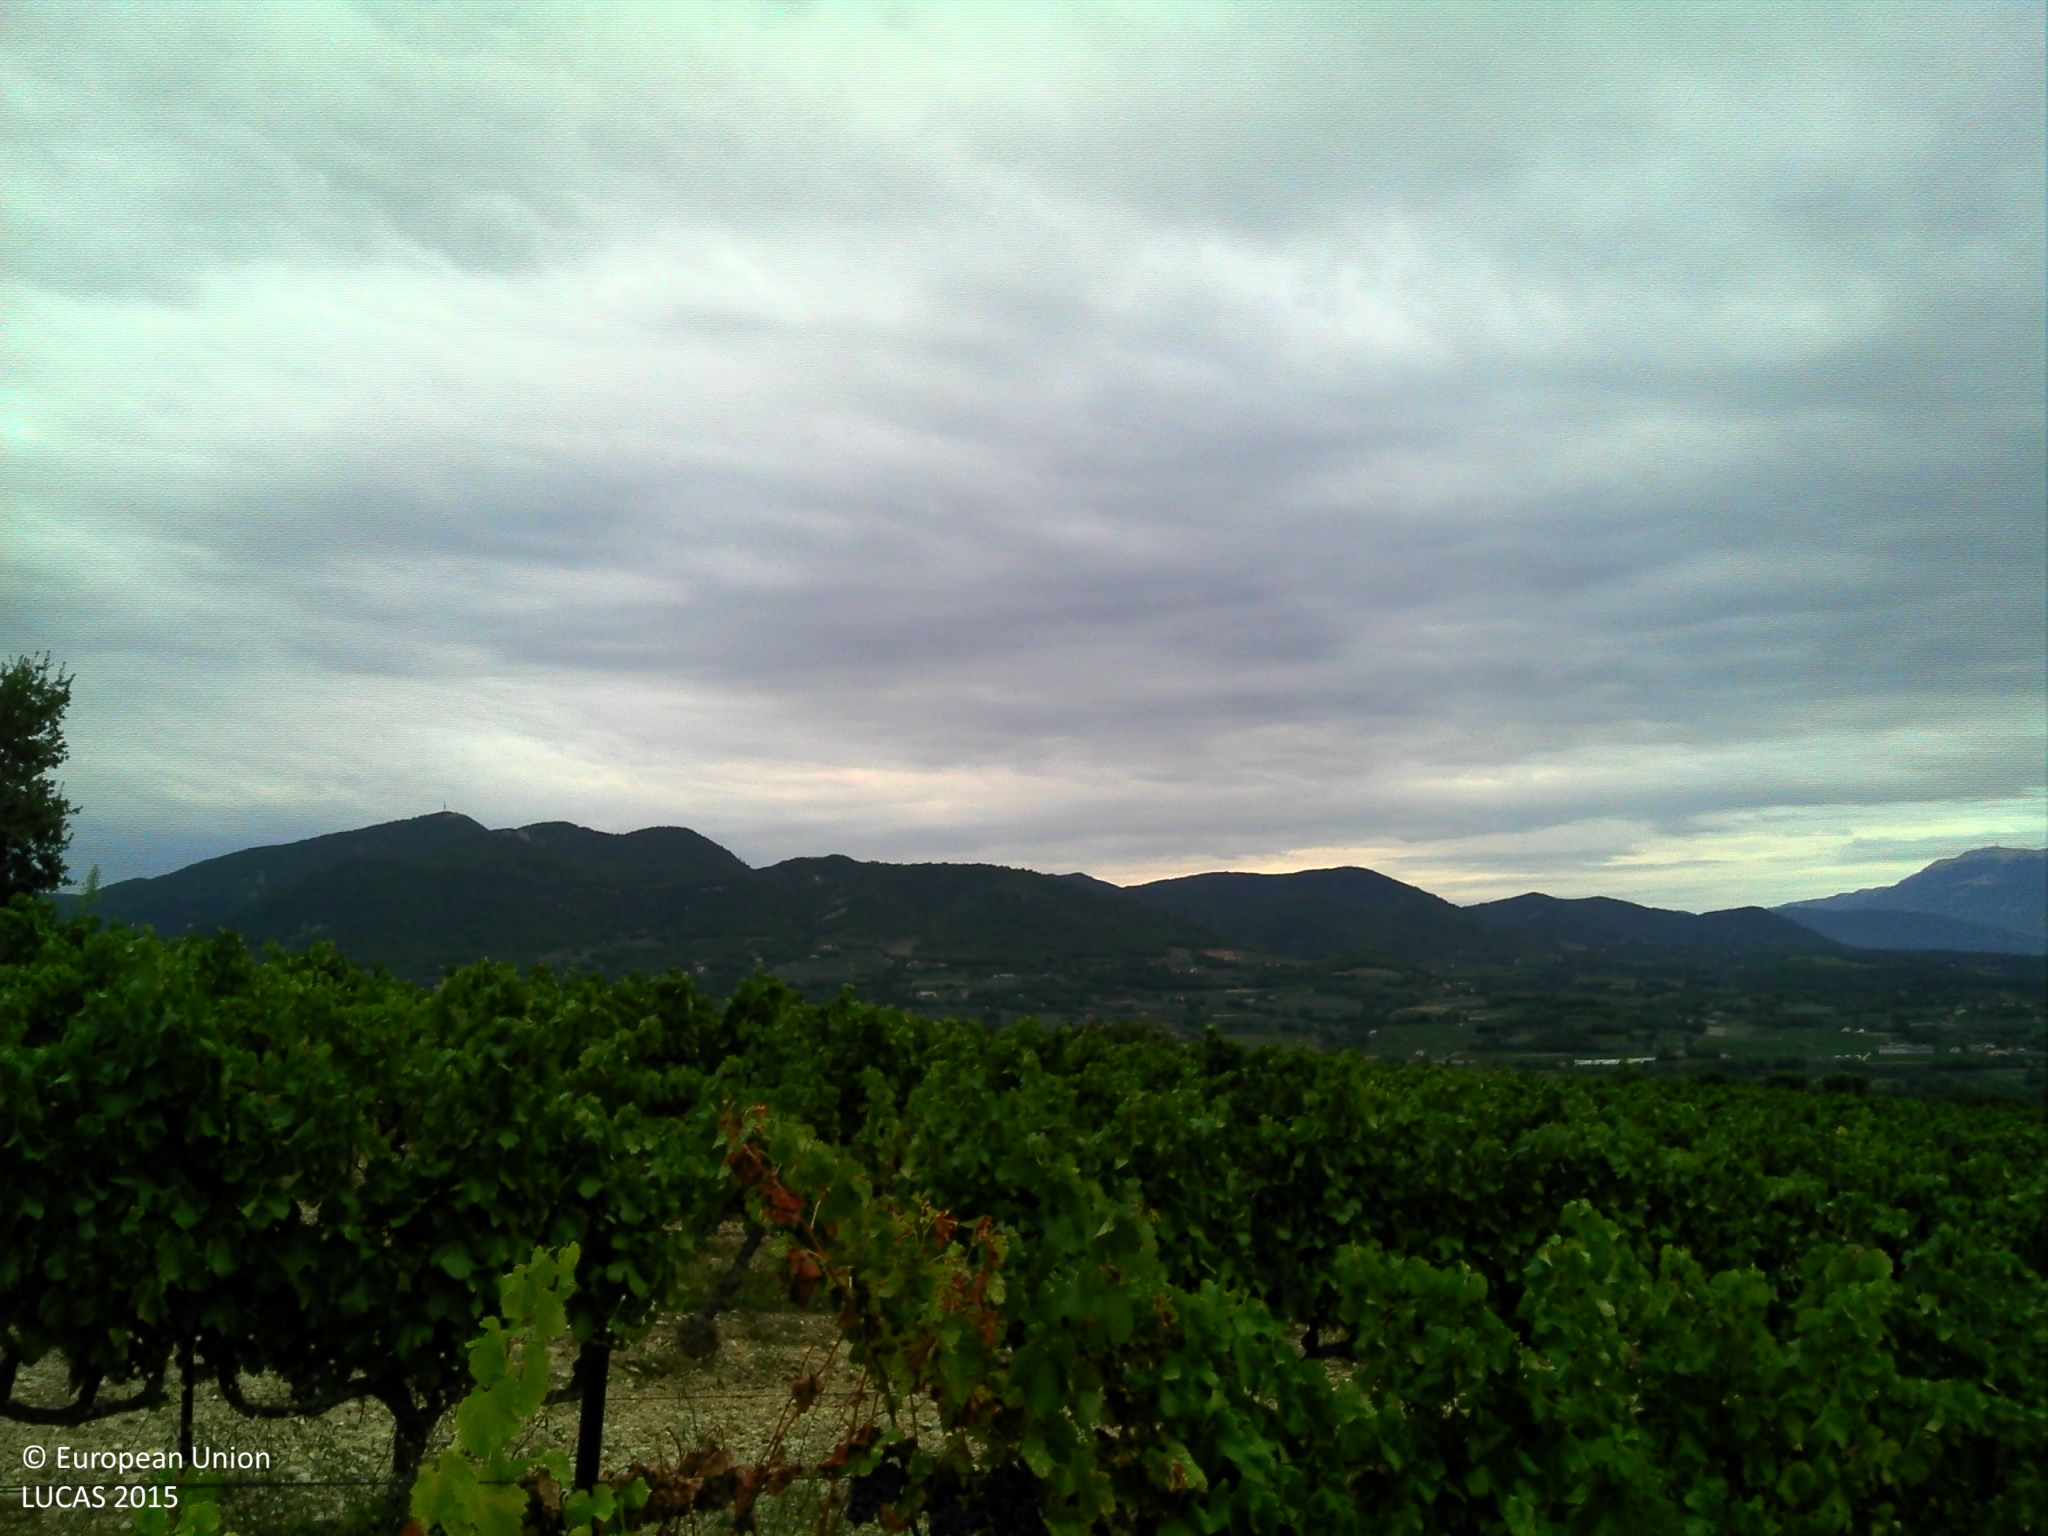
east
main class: Cropland
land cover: Vineyards
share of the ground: 50 - 75 %
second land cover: Grassland without tree/shrub cover
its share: 10 - 25 %
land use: Agriculture (excluding fallow land and kitchen gardens)
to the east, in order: Vineyards; Grassland without tree/shrub cover; Ditches and canals; Vineyards; Tracks; Vineyards; Ditches and canals; Paved roads, cycling and walking lanes; Grass margins; Pine dominated mixed woodland; Vineyards
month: September
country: FR
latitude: 44.3422
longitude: 5.0780
